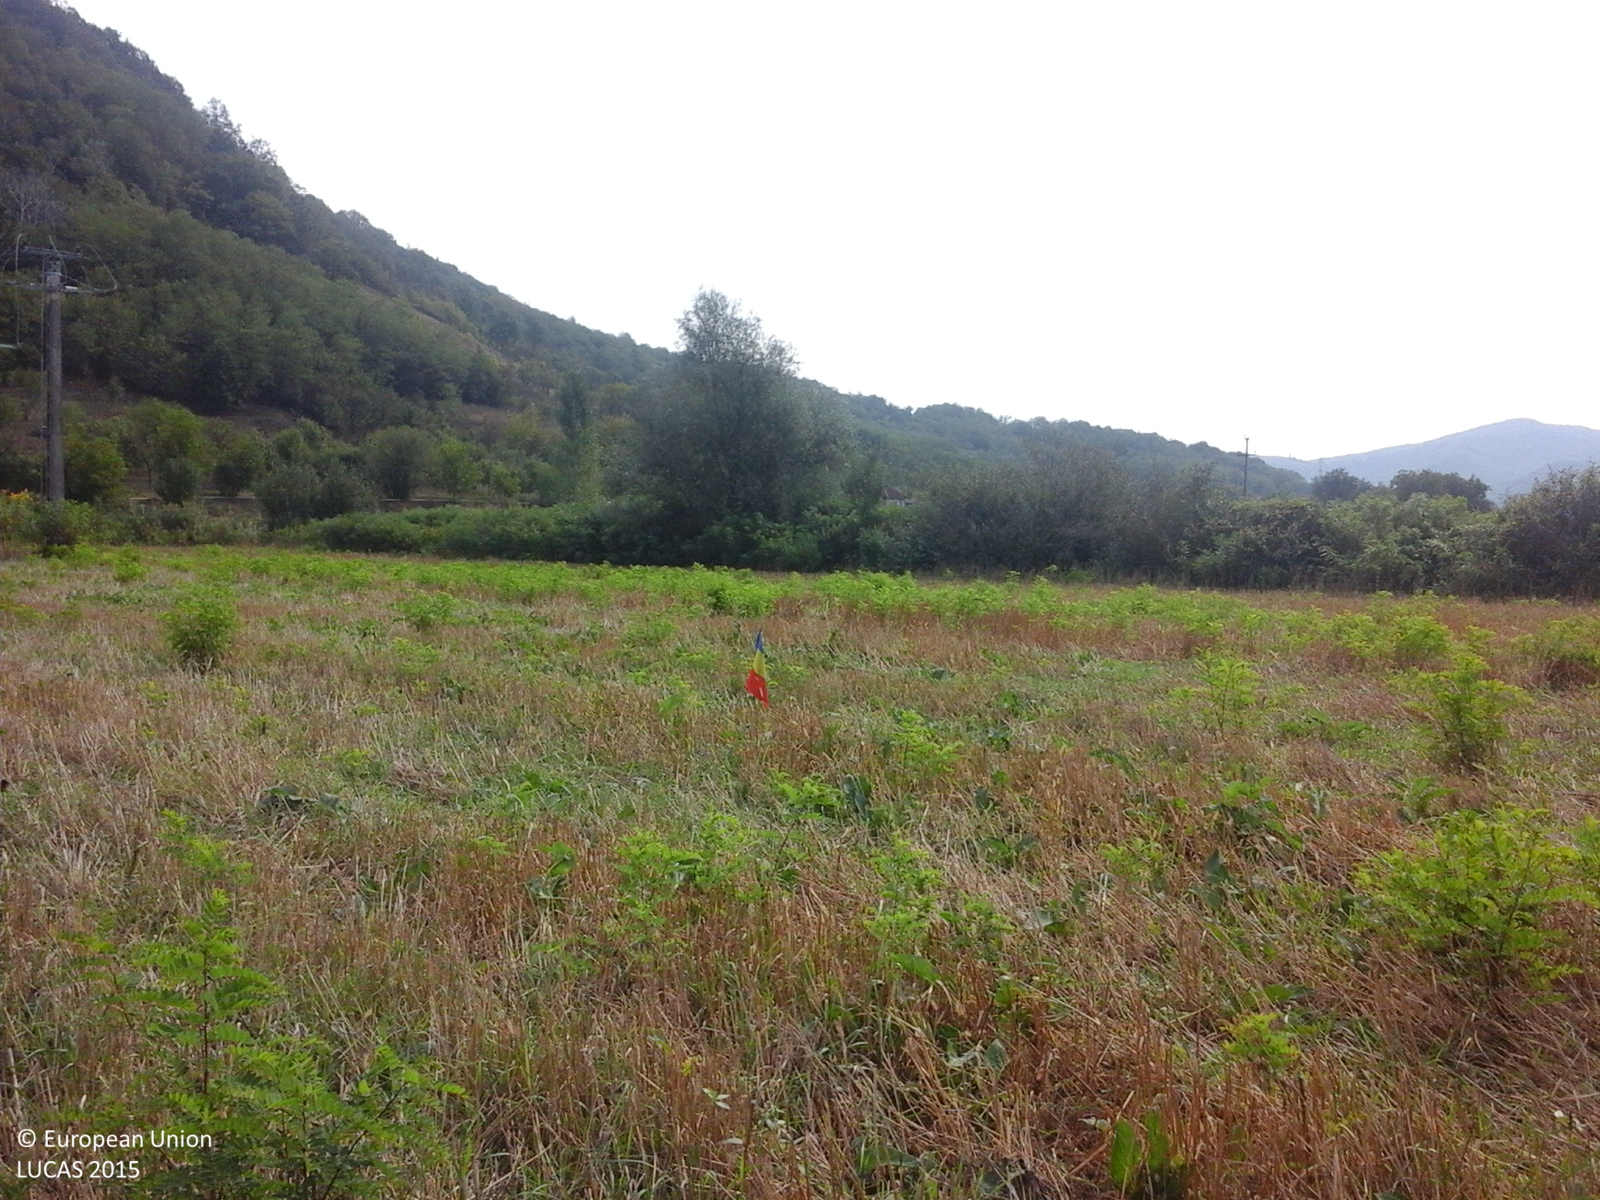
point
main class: Cropland
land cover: Oats
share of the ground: 25 - 50 %
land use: Agriculture (excluding fallow land and kitchen gardens)
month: September
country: RO
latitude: 47.2781
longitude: 23.6519
